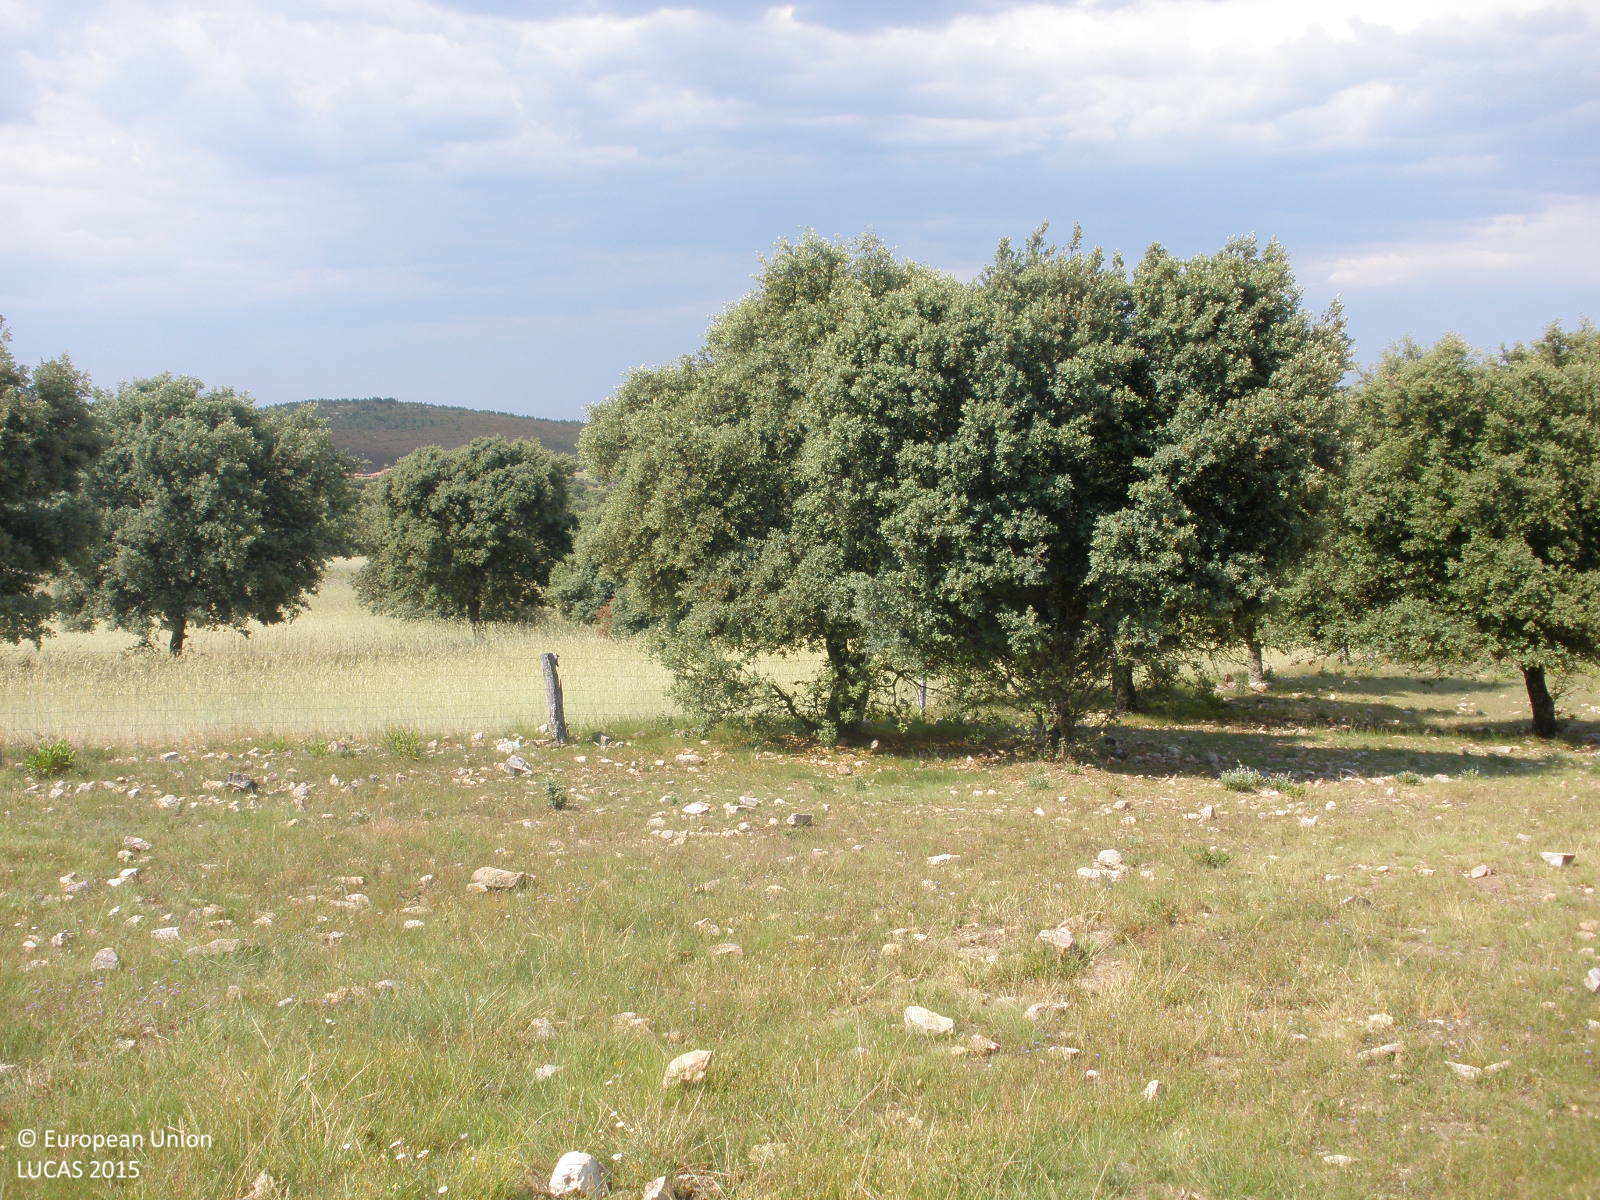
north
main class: Grassland
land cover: Grassland with sparse tree/shrub cover
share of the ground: > 75 %
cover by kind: herbaceous plants 95 %, broadleaved forest trees 5 %
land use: Agriculture (excluding fallow land and kitchen gardens)
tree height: < 5 m
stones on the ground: 10 - 25 %
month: June
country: ES
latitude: 40.5511
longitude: -6.2974
